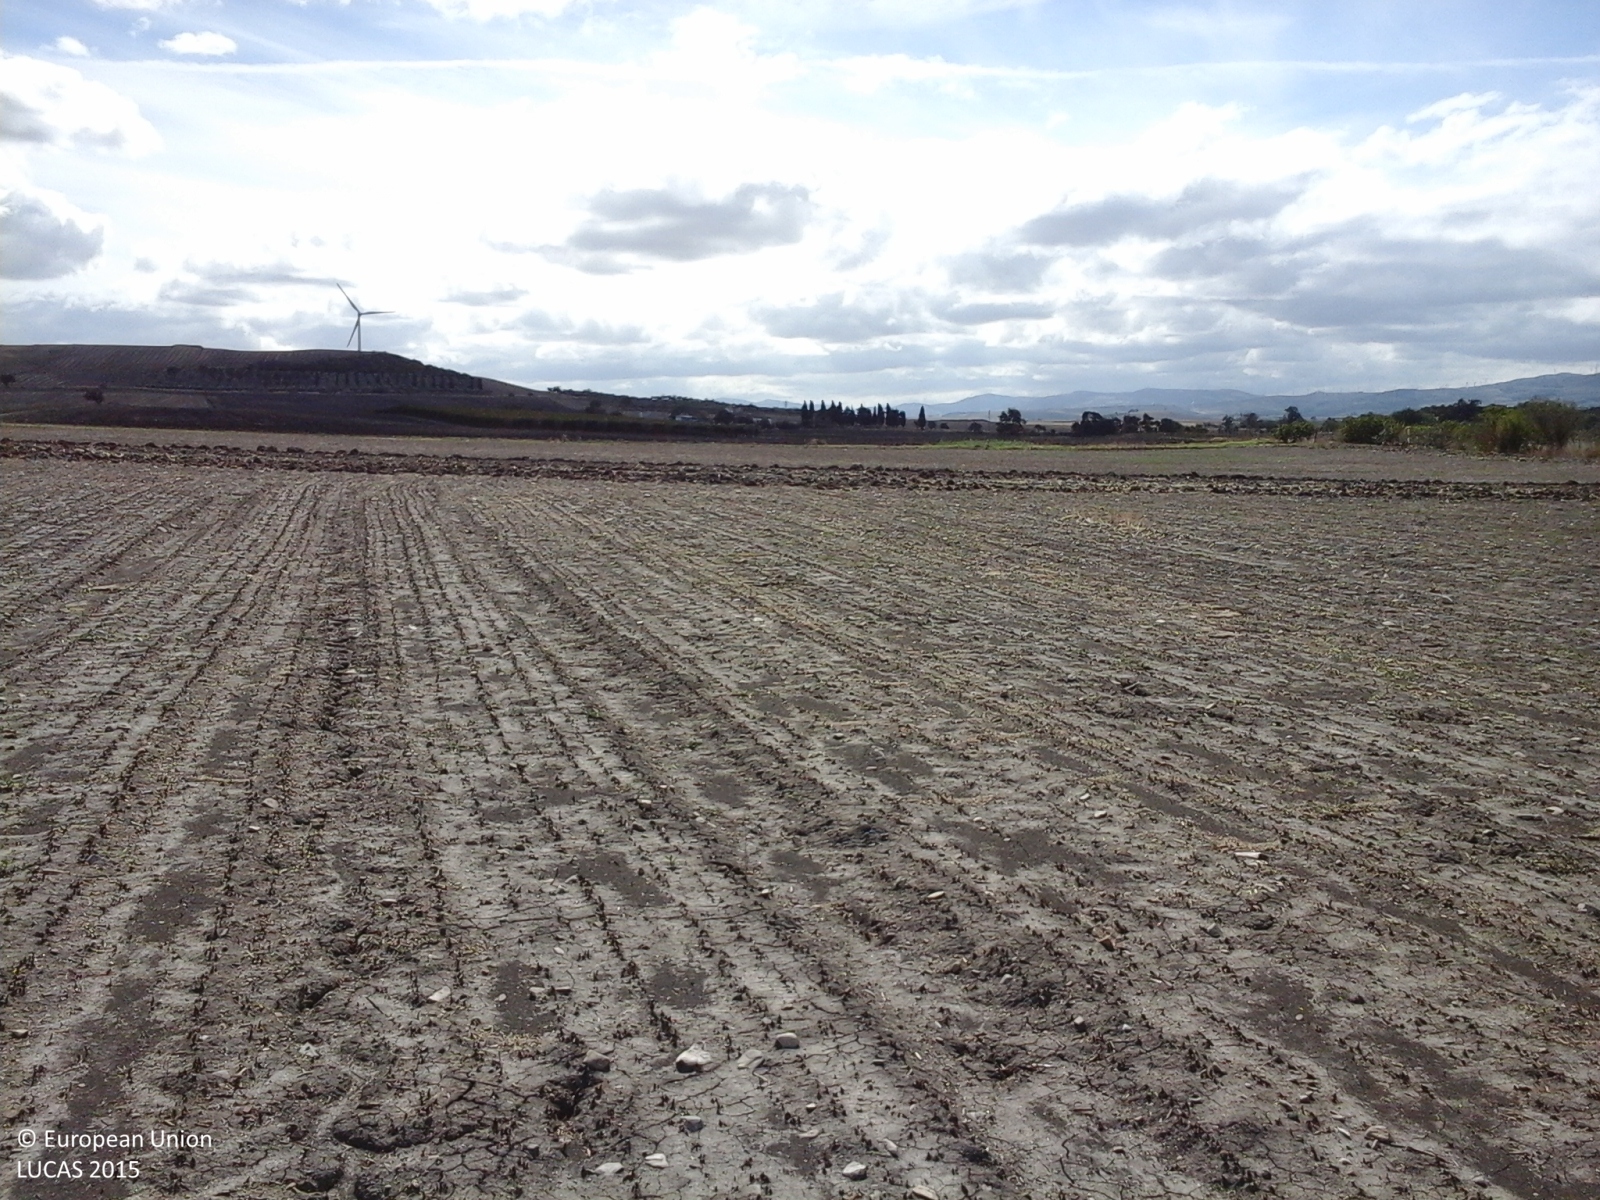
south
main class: Cropland
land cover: Durum wheat
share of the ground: > 75 %
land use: Agriculture (excluding fallow land and kitchen gardens)
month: September
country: IT
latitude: 41.6332
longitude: 15.2049
